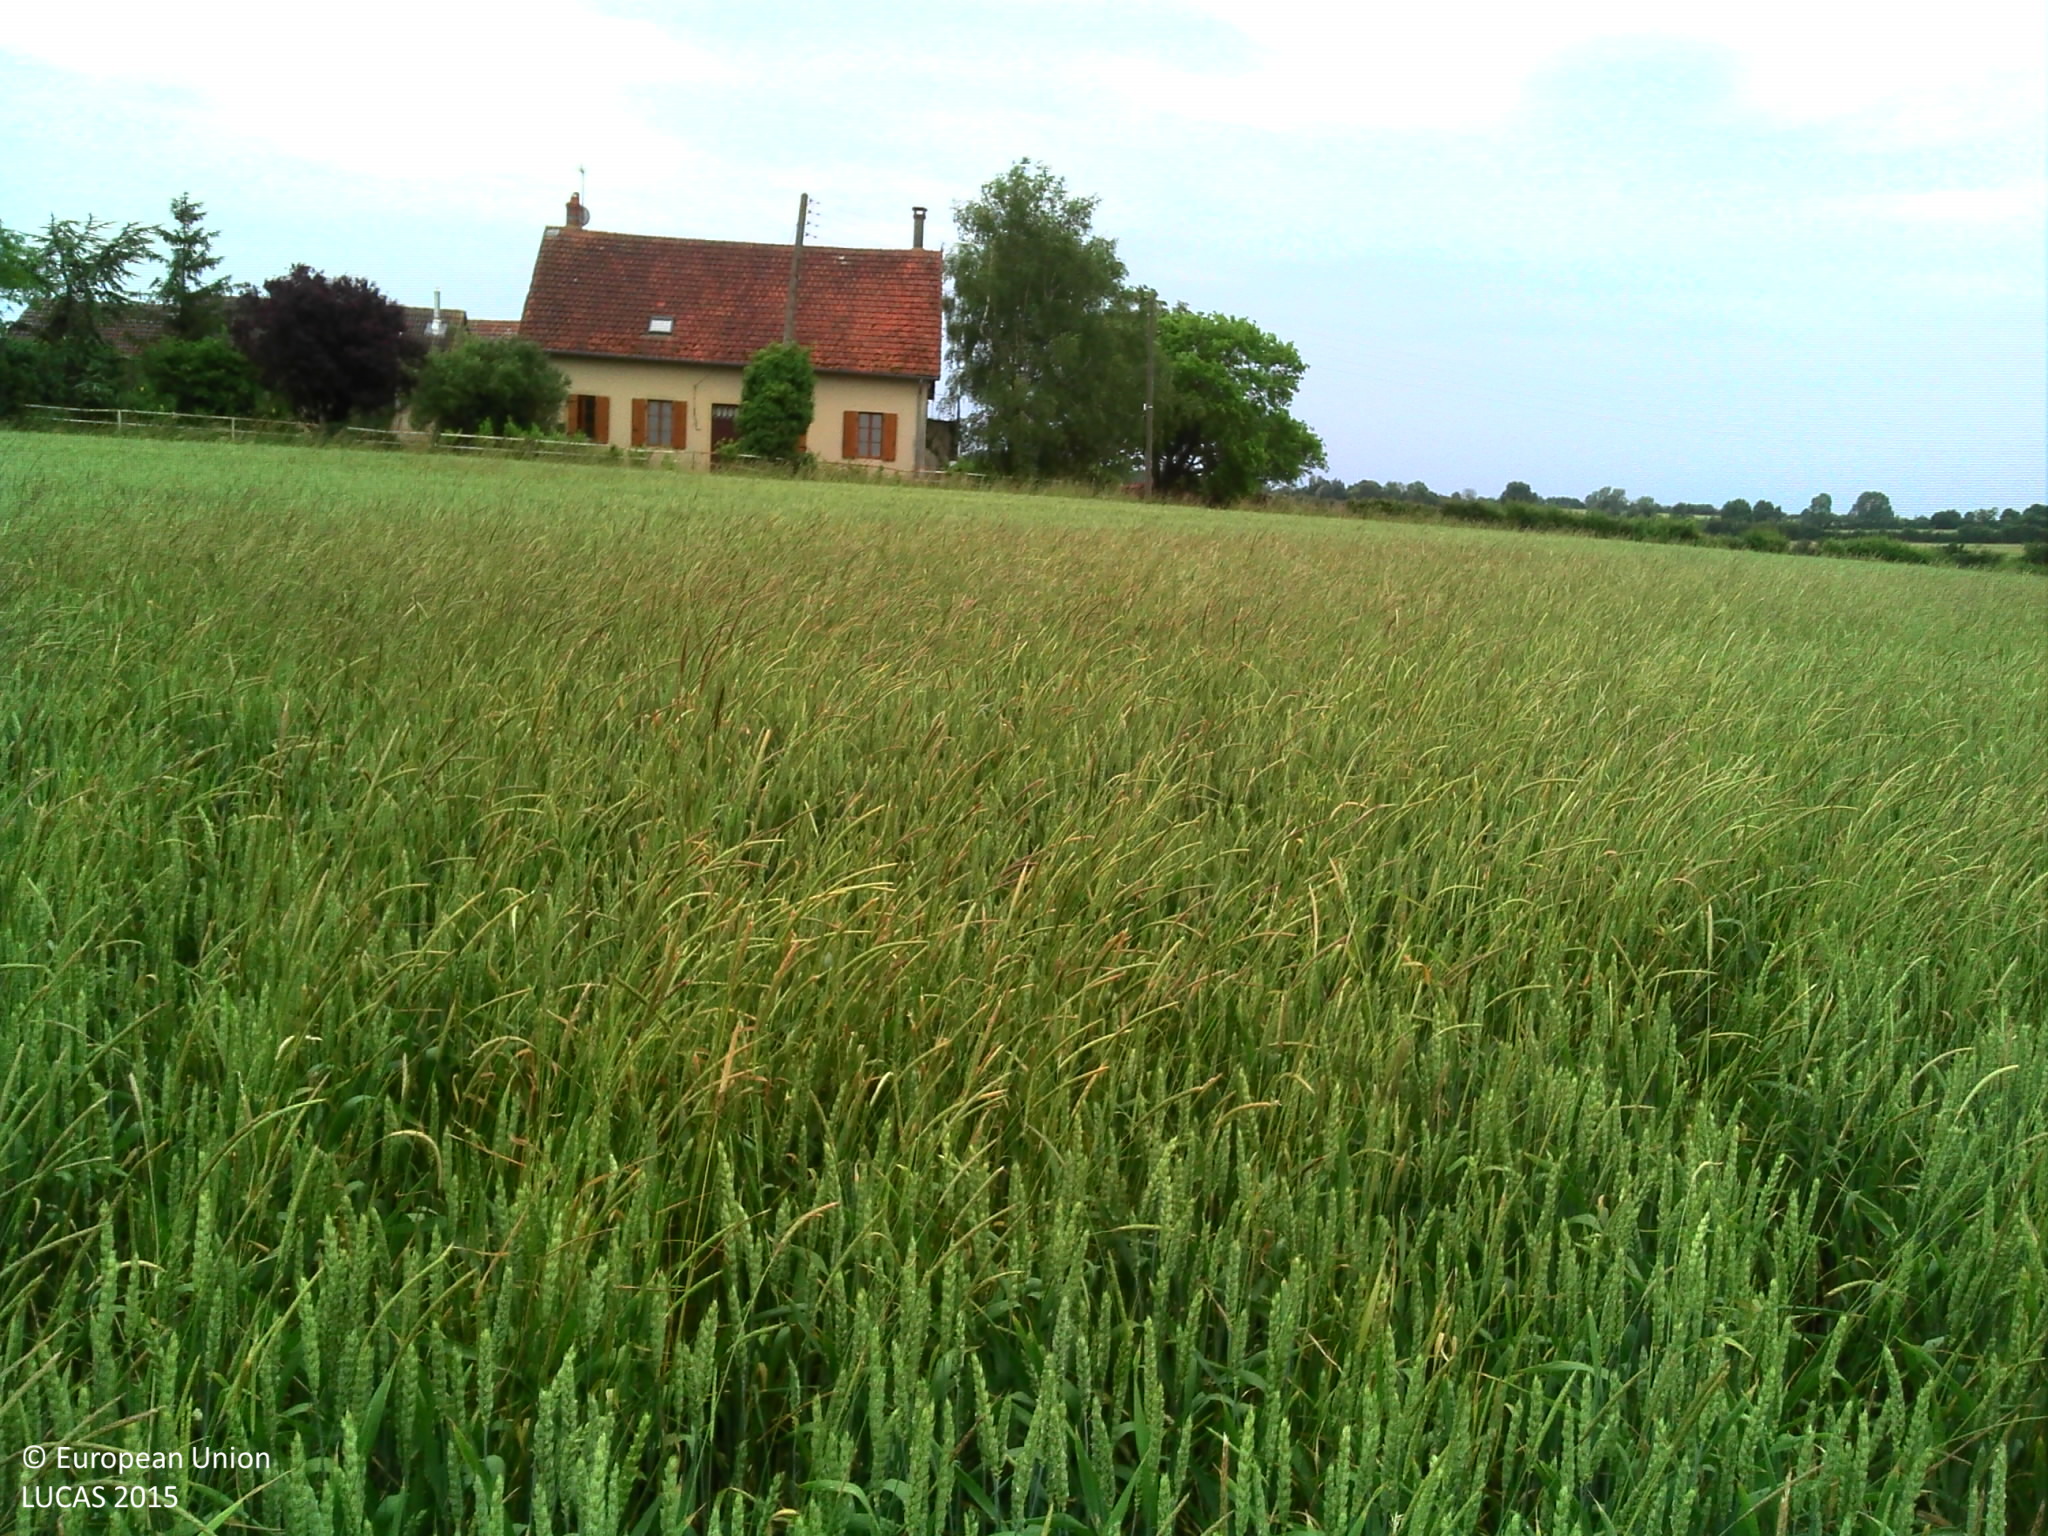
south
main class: Cropland
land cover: Common wheat
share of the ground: > 75 %
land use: Agriculture (excluding fallow land and kitchen gardens)
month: June
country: FR
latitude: 46.7885
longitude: 2.6985
